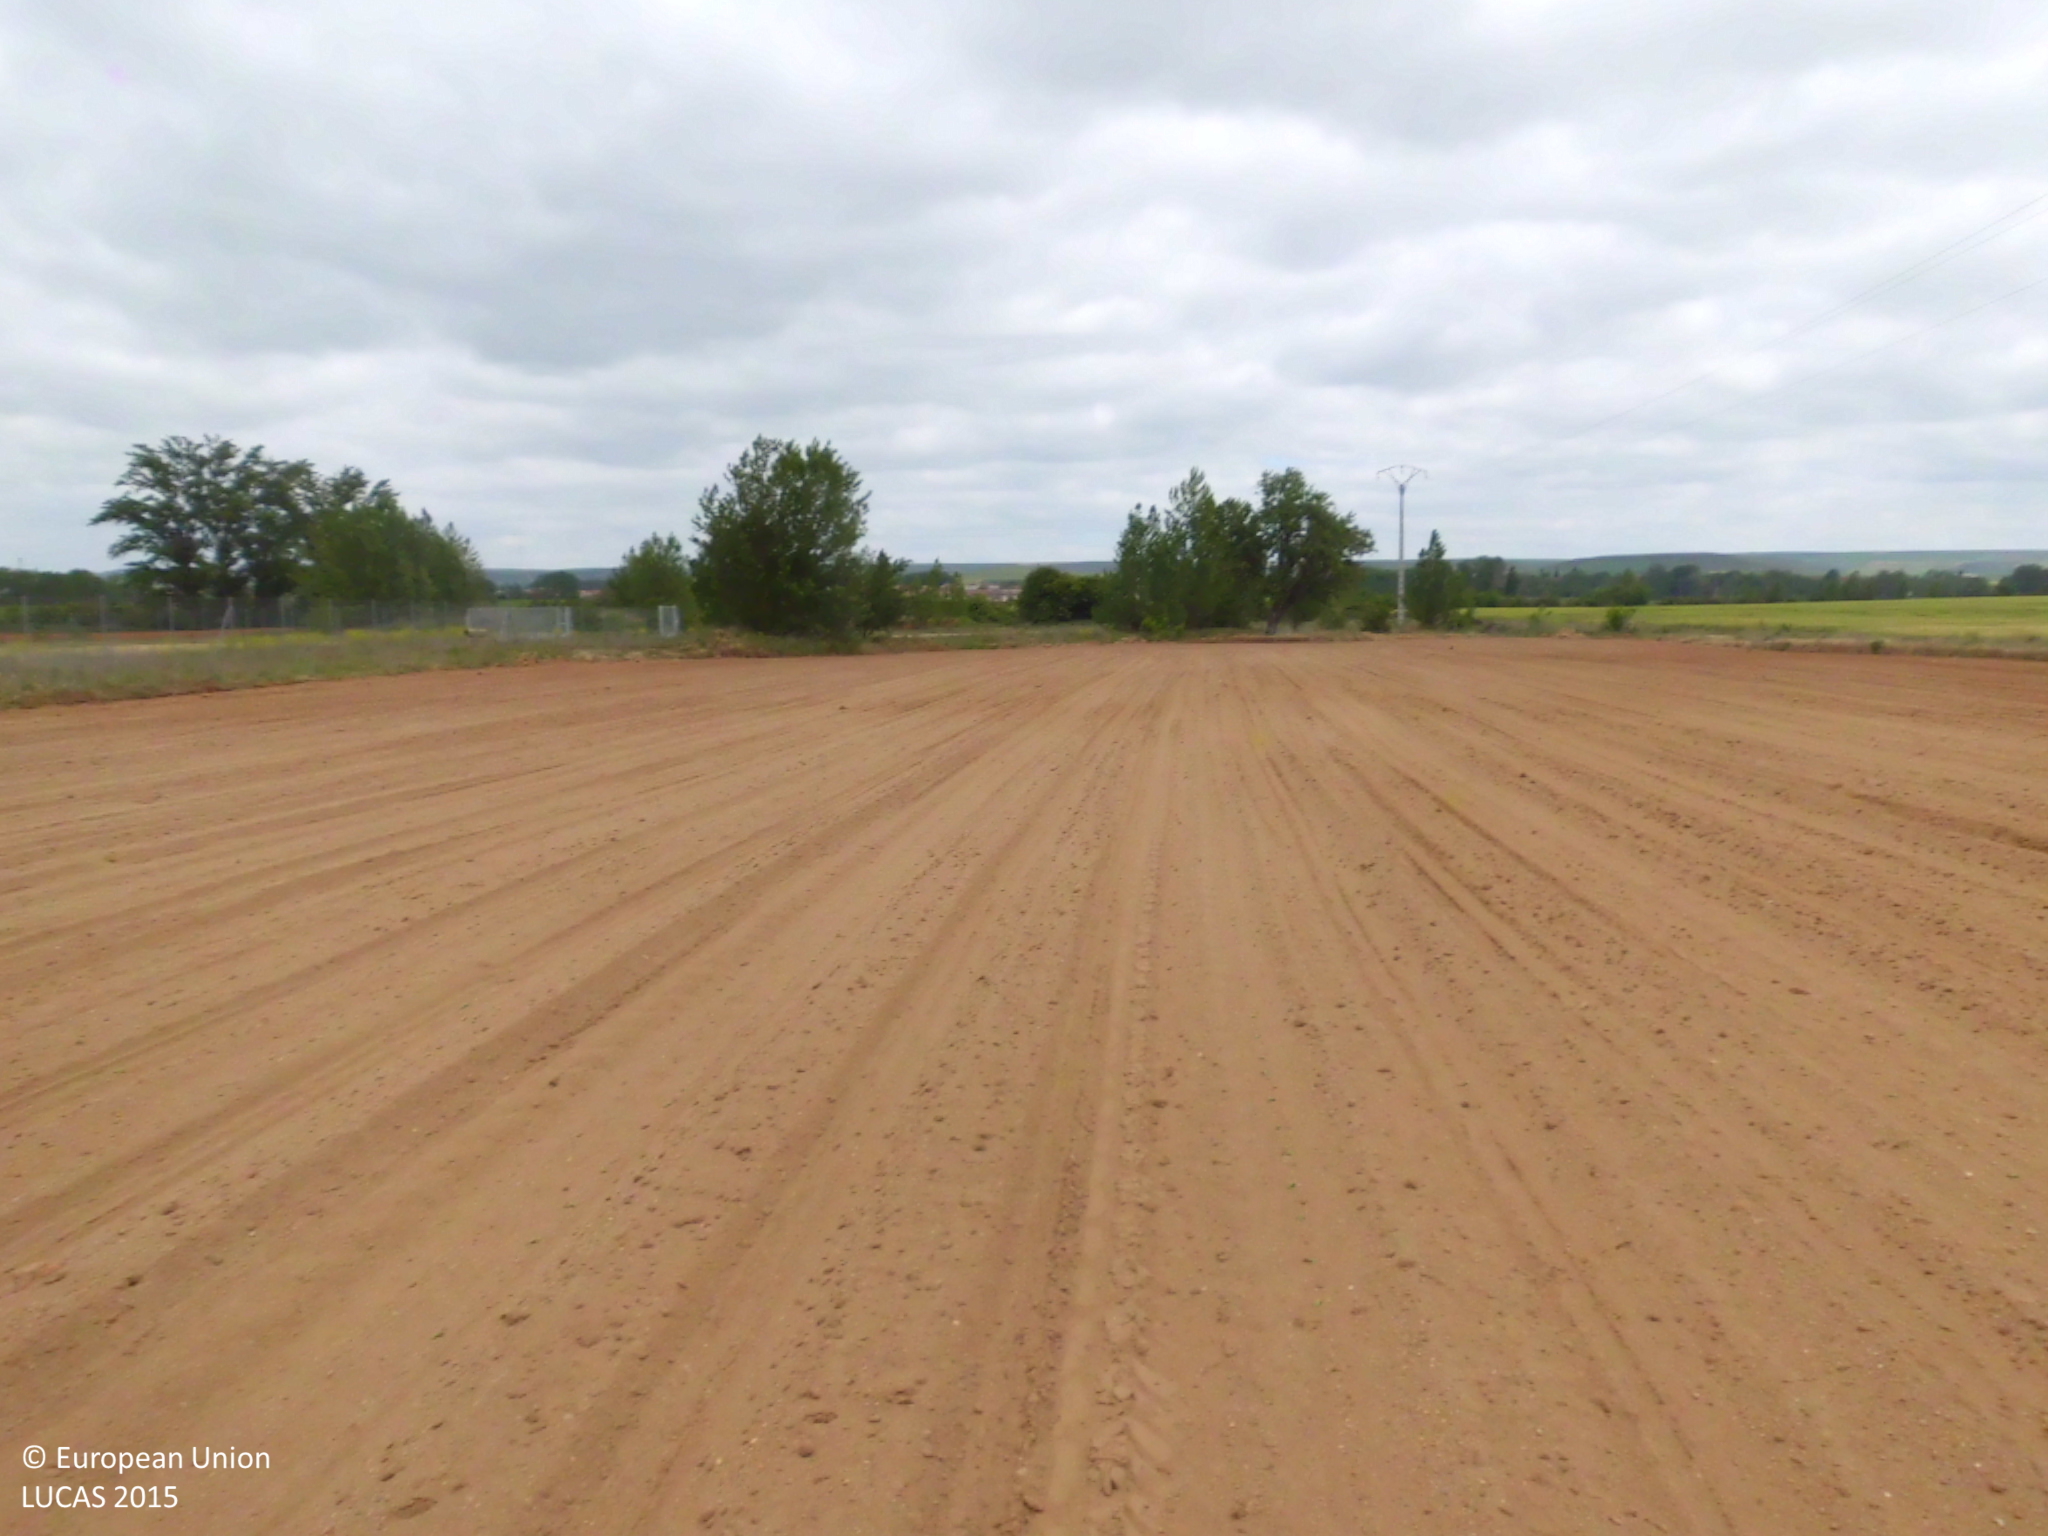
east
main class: Cropland
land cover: Sunflower
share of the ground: < 10 %
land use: Agriculture (excluding fallow land and kitchen gardens)
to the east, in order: Sunflower; Grassland with sparse tree/shrub cover; Tracks; Grassland with sparse tree/shrub cover; Groves; Ditches and canals; Grassland with sparse tree/shrub cover; Electric lines; Grassland without tree/shrub cover
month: May
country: ES
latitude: 42.5141
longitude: -4.0280
